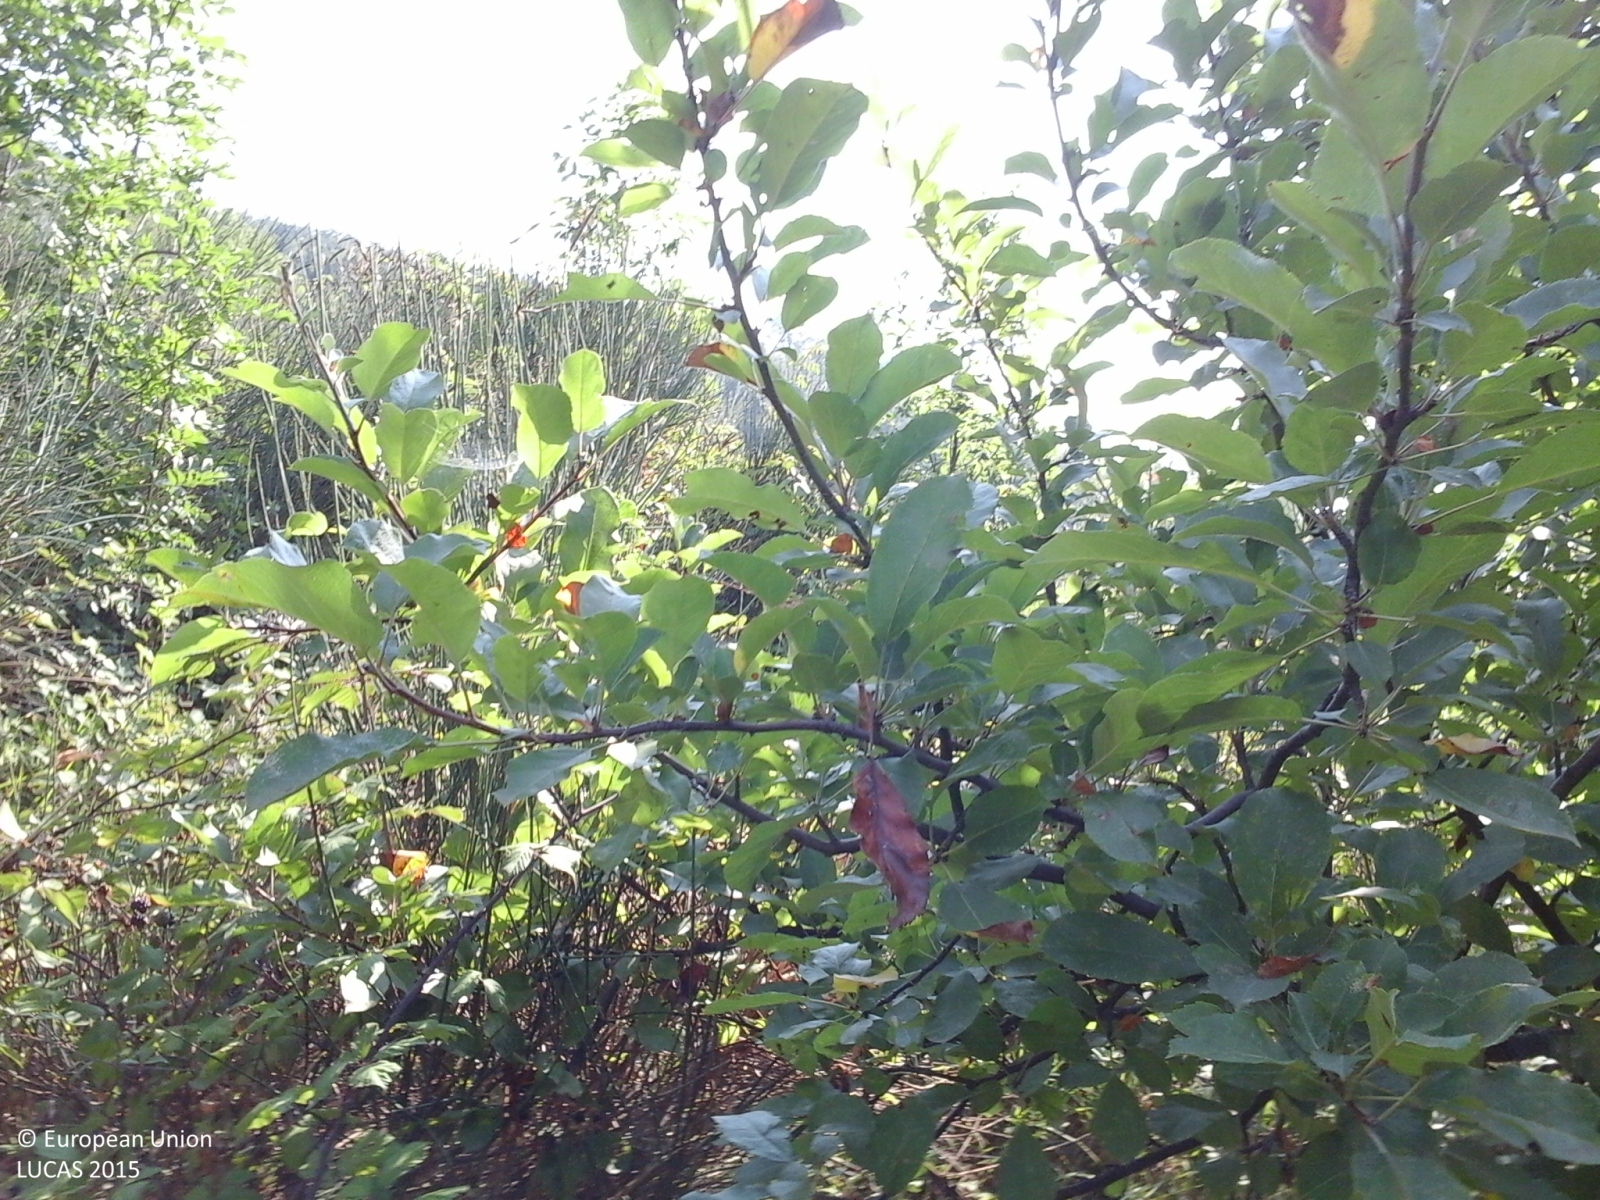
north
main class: Woodland
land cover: Broadleaved woodland
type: thermophilous deciduous forest
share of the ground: > 75 %
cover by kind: broadleaved forest trees 70 %, shrubs 15 %, coniferous forest trees 10 %, herbaceous plants 5 %
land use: Forestry
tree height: > 5 m
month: August
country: IT
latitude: 44.0245
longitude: 12.0039
